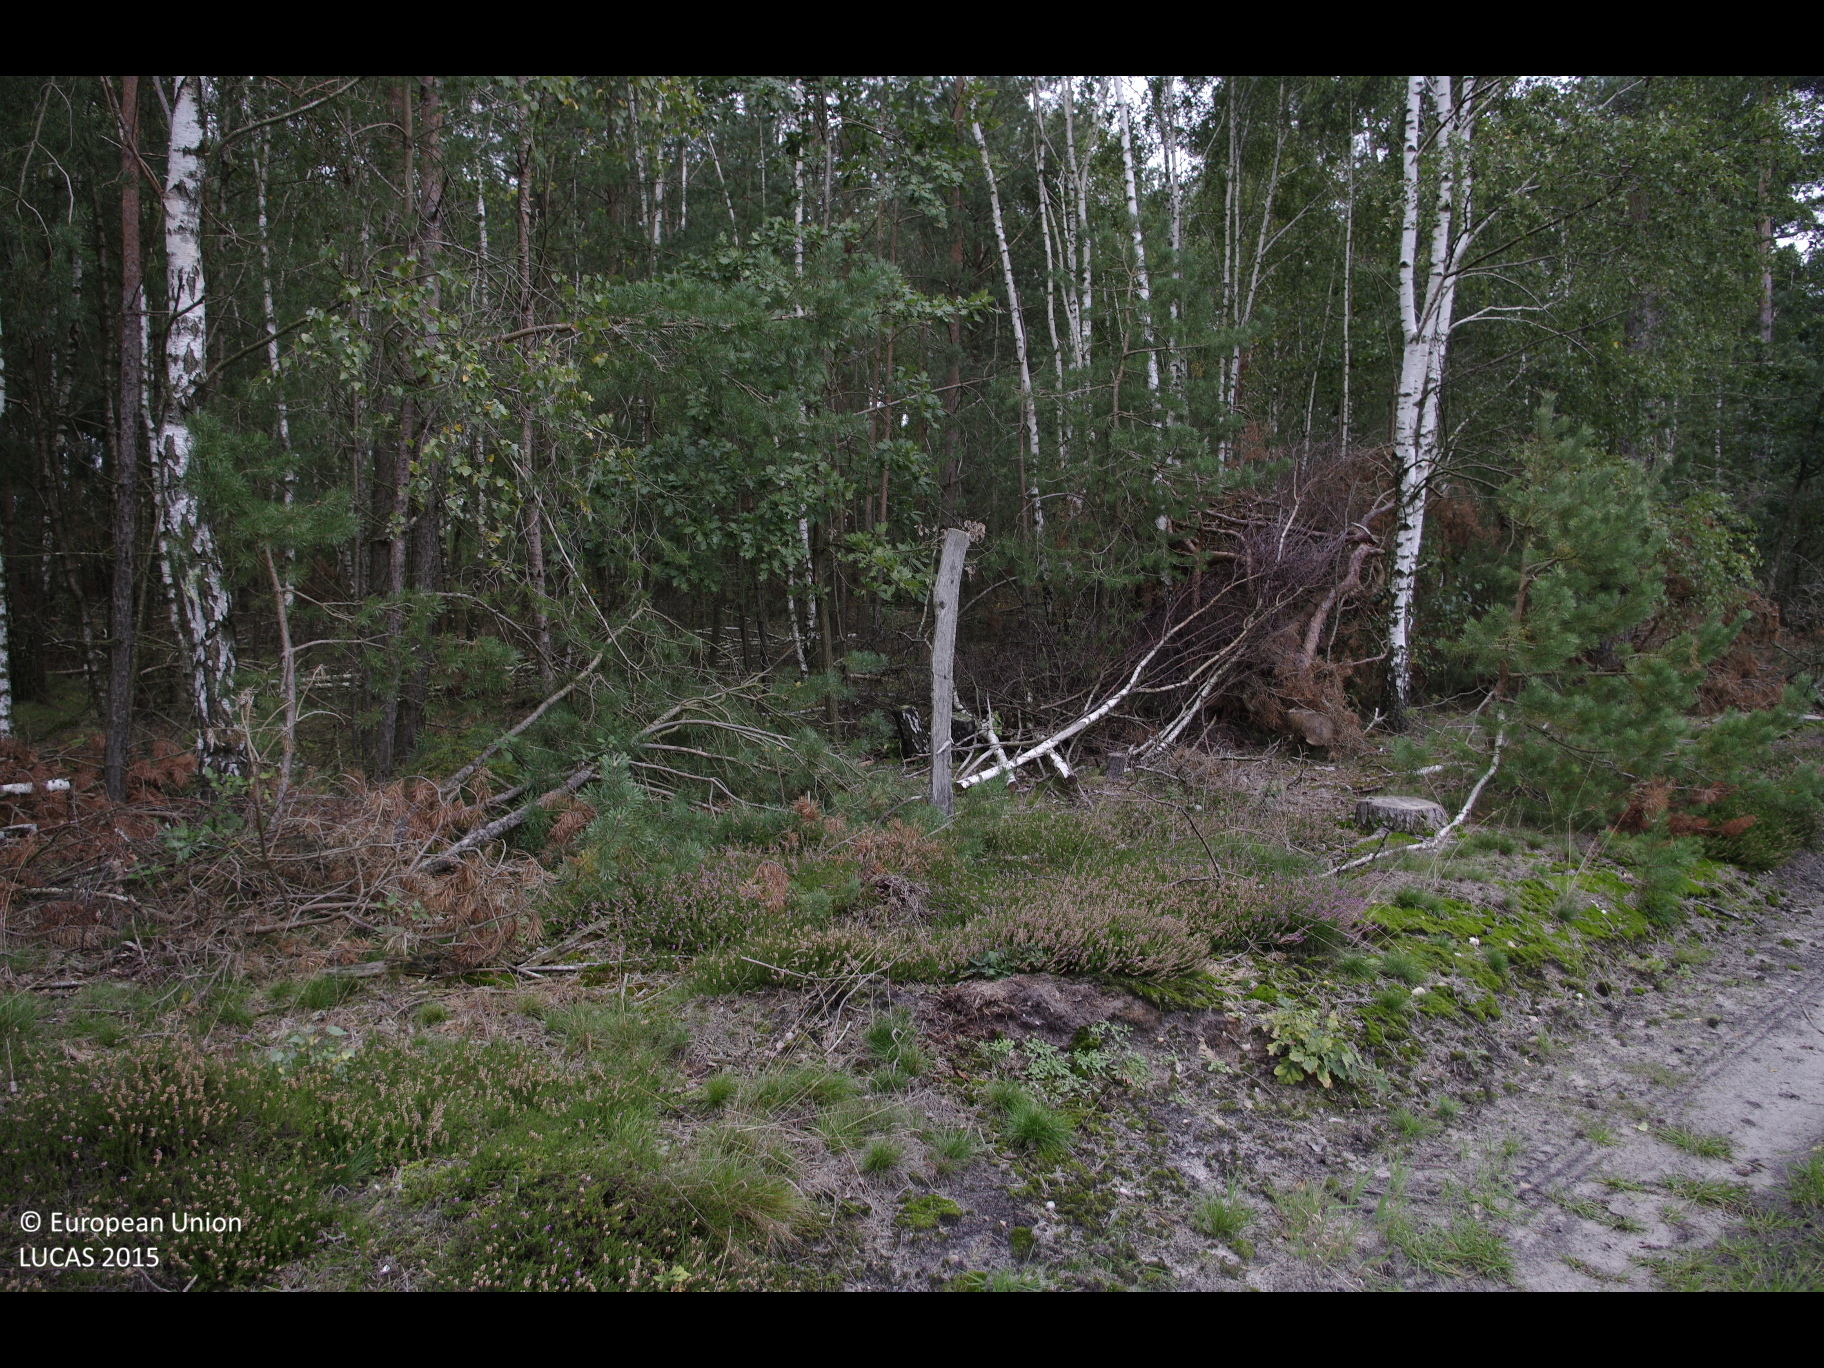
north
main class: Woodland
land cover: Pine dominated mixed woodland
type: hemiboreal forest and nemoral coniferous forest and mixed broadleaved-coniferous forest
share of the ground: > 75 %
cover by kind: coniferous forest trees 50 %, broadleaved forest trees 40 %, herbaceous plants 10 %
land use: Forestry
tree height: > 5 m
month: September
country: DE
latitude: 53.0963
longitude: 9.8657
